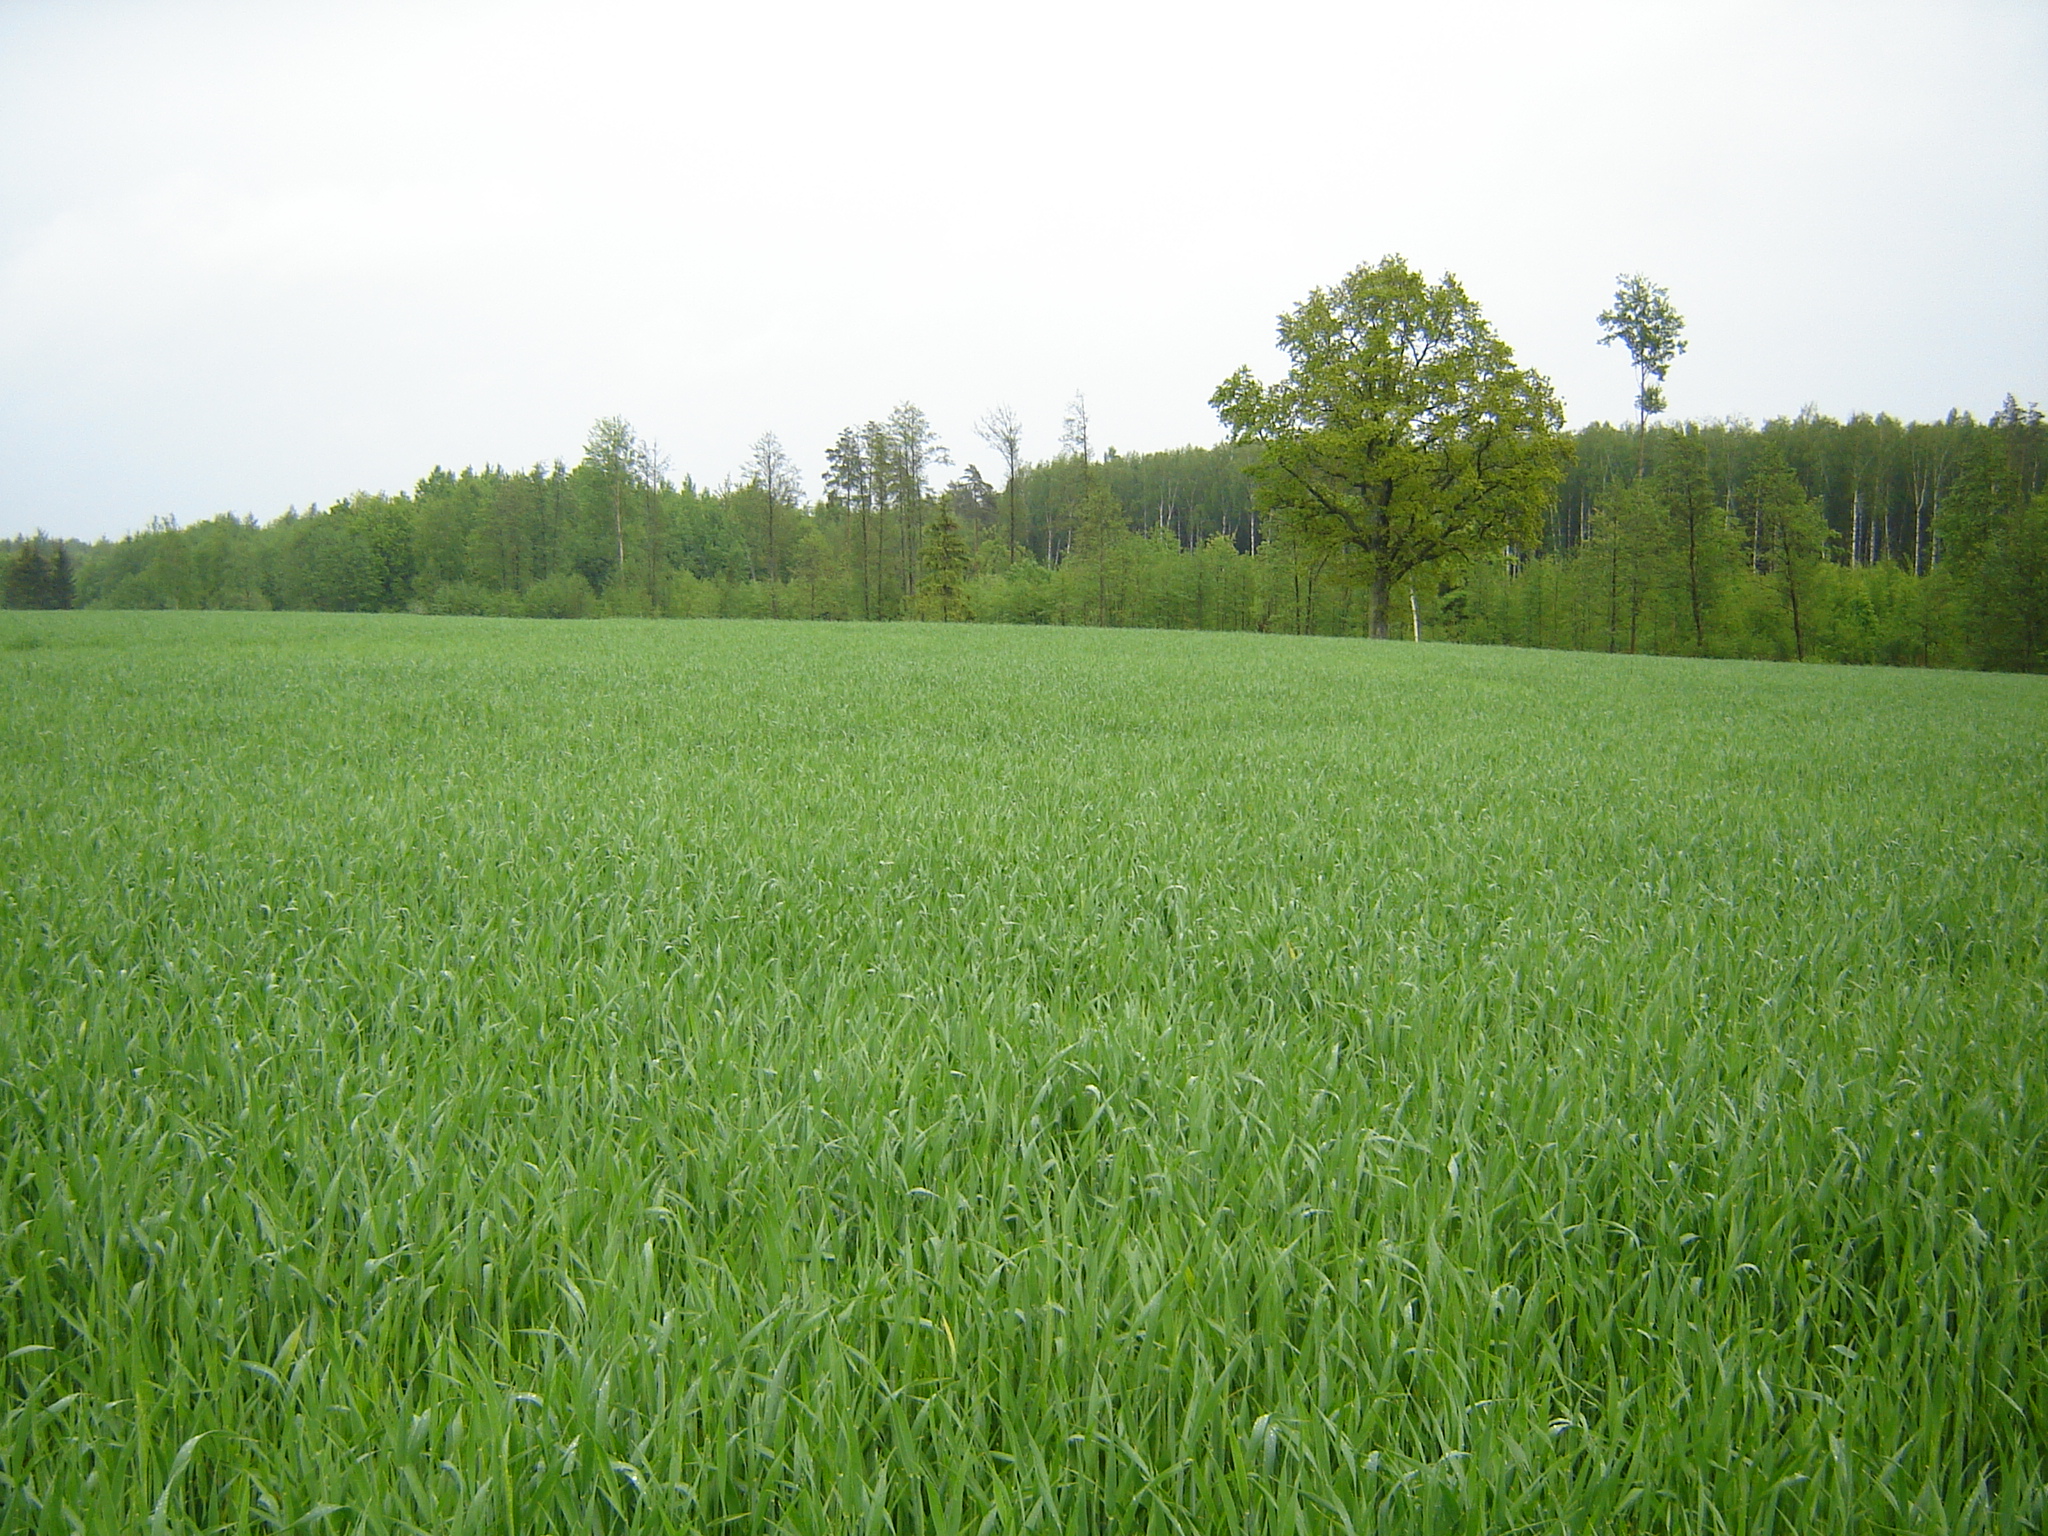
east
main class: Cropland
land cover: Common wheat
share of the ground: > 75 %
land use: Agriculture (excluding fallow land and kitchen gardens)
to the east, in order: Common wheat; Shruby margins; Ditches and canals; Broadleaved woodland; Tracks; Broadleaved woodland
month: May
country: LT
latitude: 55.9296
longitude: 25.2414
